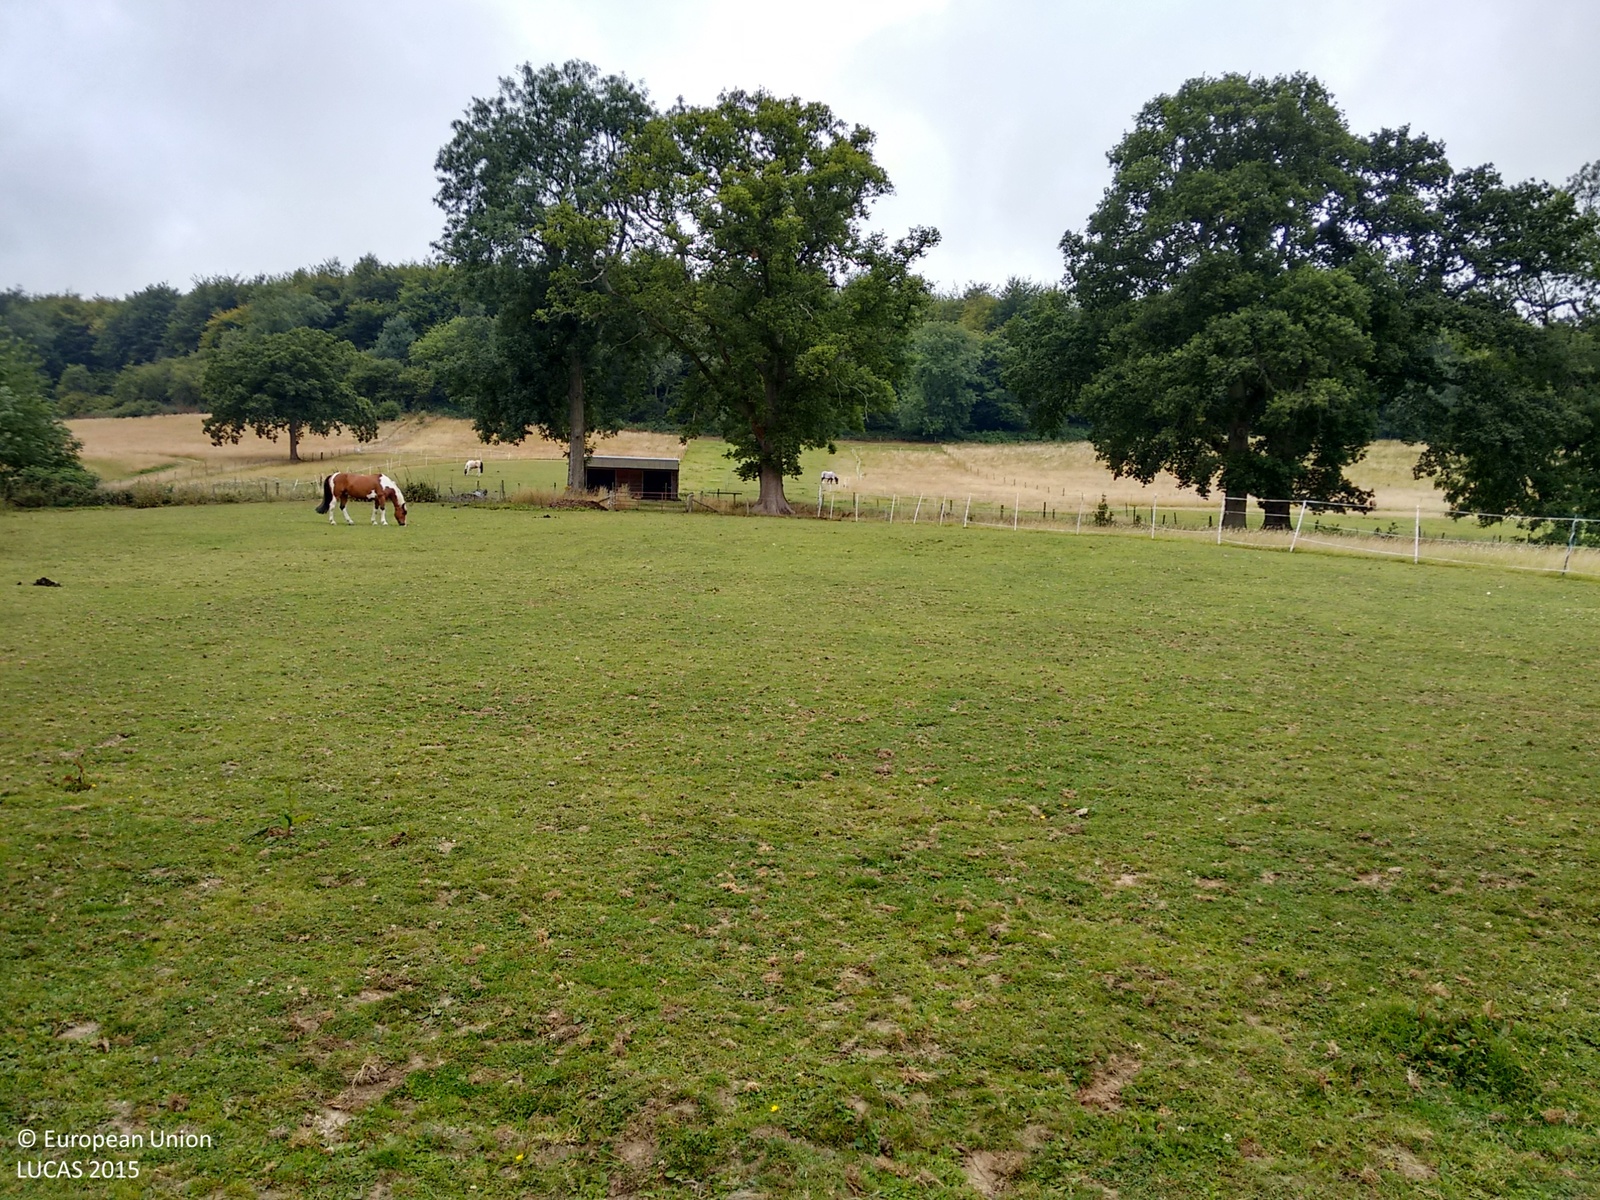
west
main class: Grassland
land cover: Grassland without tree/shrub cover
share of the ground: > 75 %
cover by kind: herbaceous plants 80 %, unconsolidated bare surface 20 %
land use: Agriculture (excluding fallow land and kitchen gardens)
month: August
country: GB
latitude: 51.1982
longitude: -0.3549
